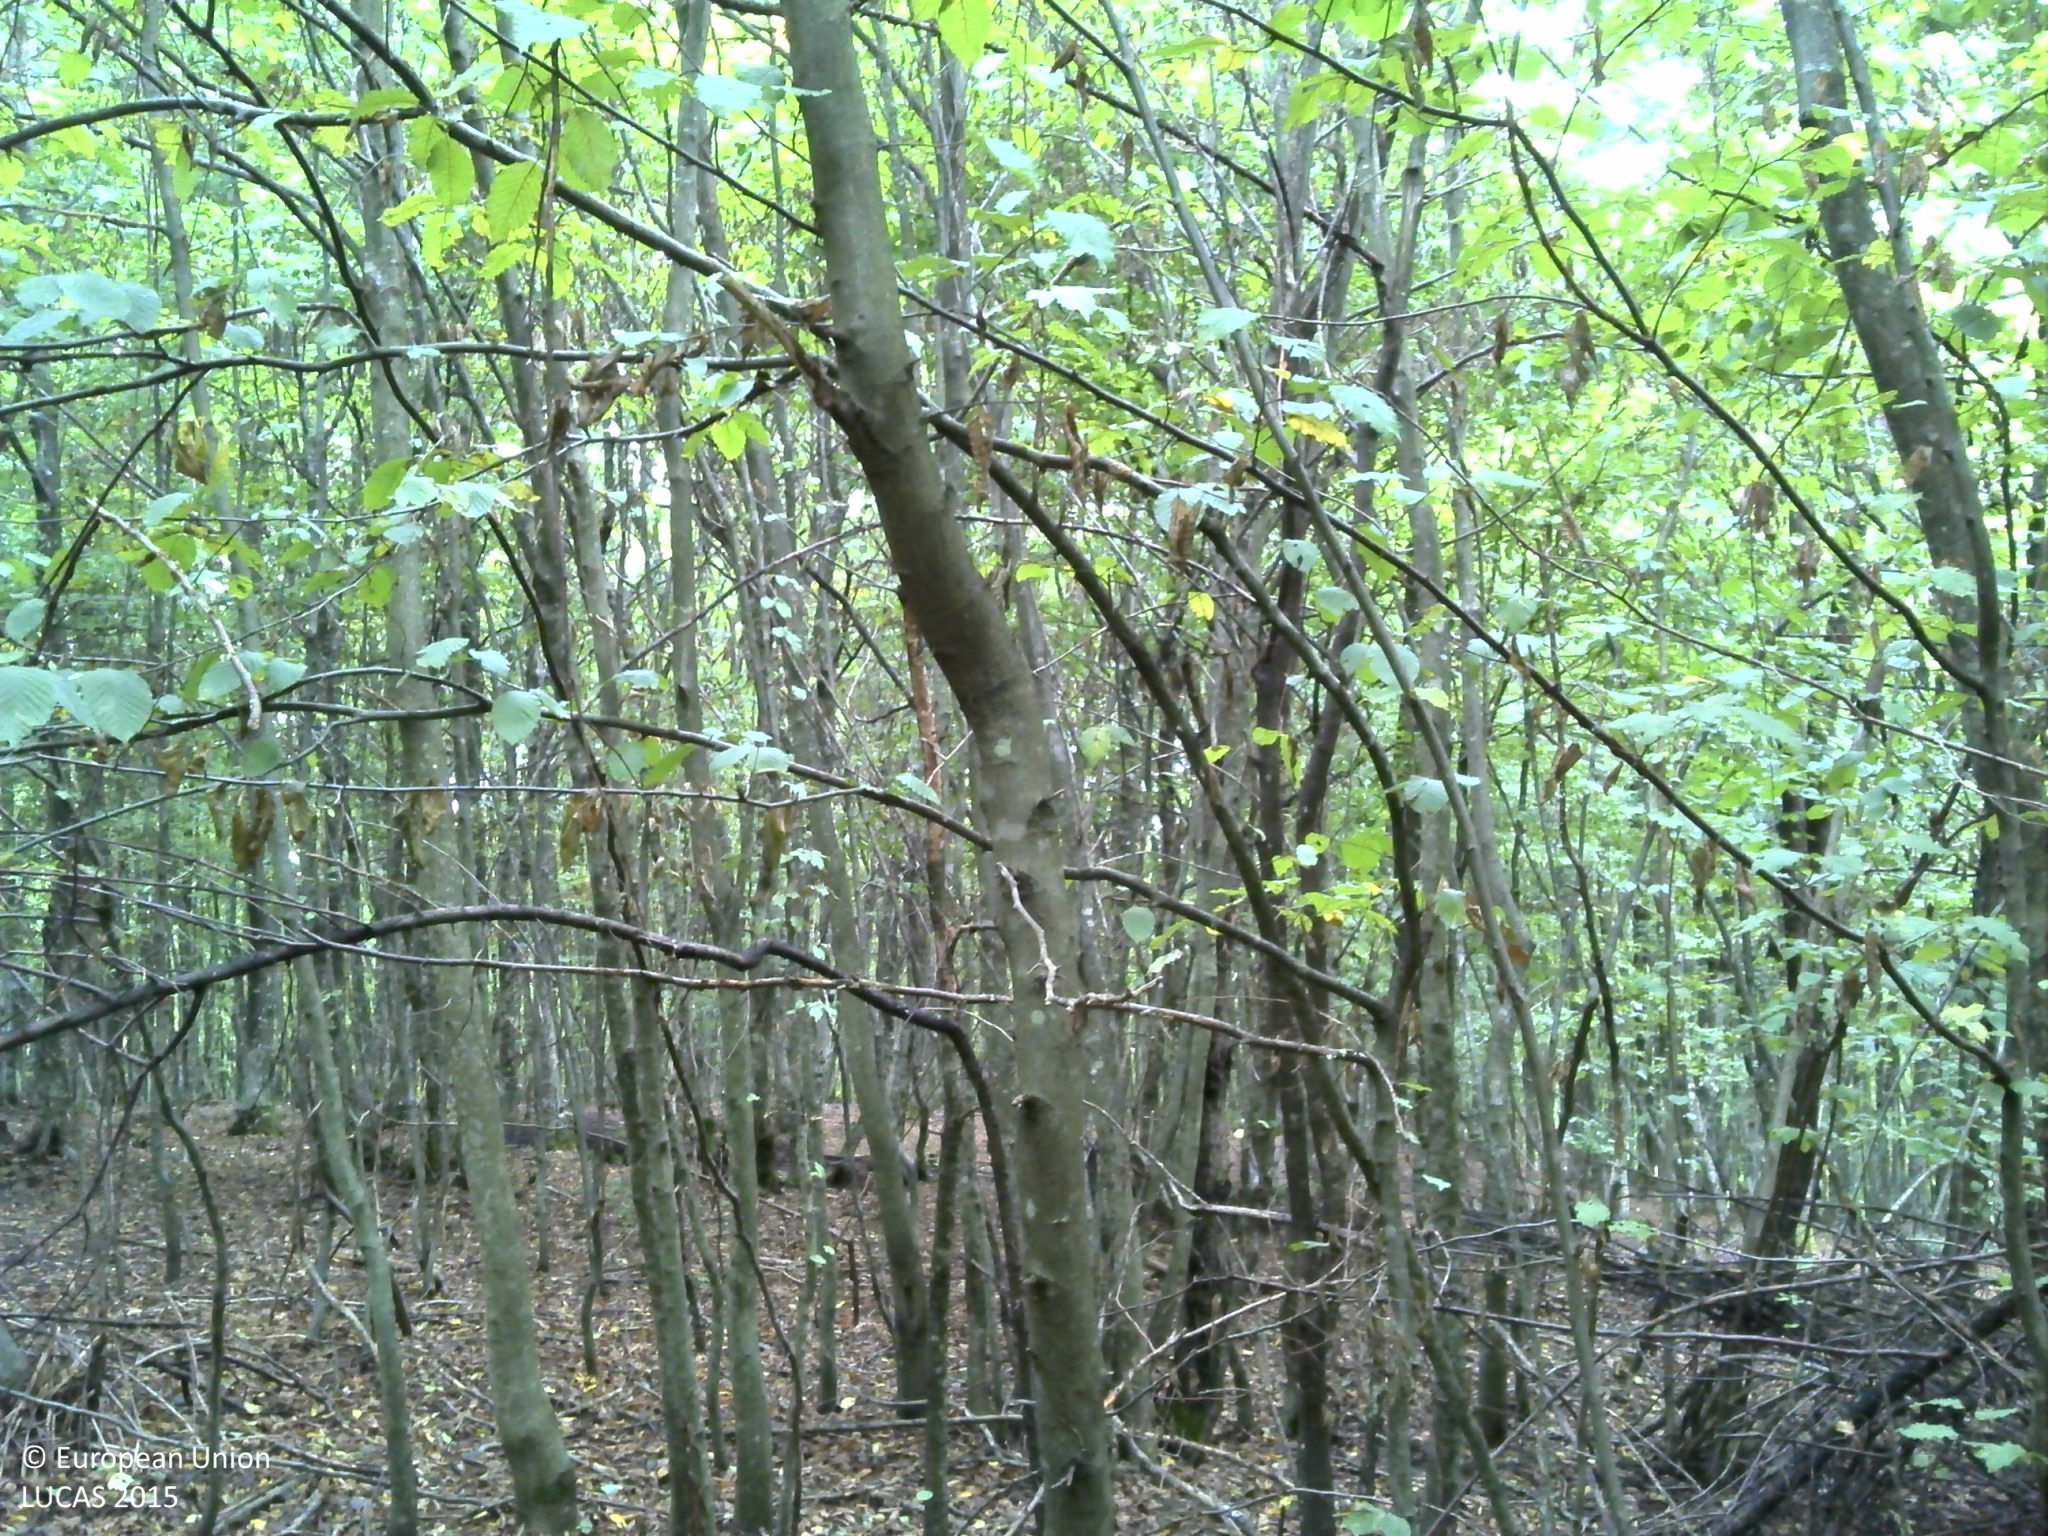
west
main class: Woodland
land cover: Broadleaved woodland
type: beech forest
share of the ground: > 75 %
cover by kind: broadleaved forest trees 100 %
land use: Forestry
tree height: > 5 m
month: August
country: HR
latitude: 45.3490
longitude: 15.7270
